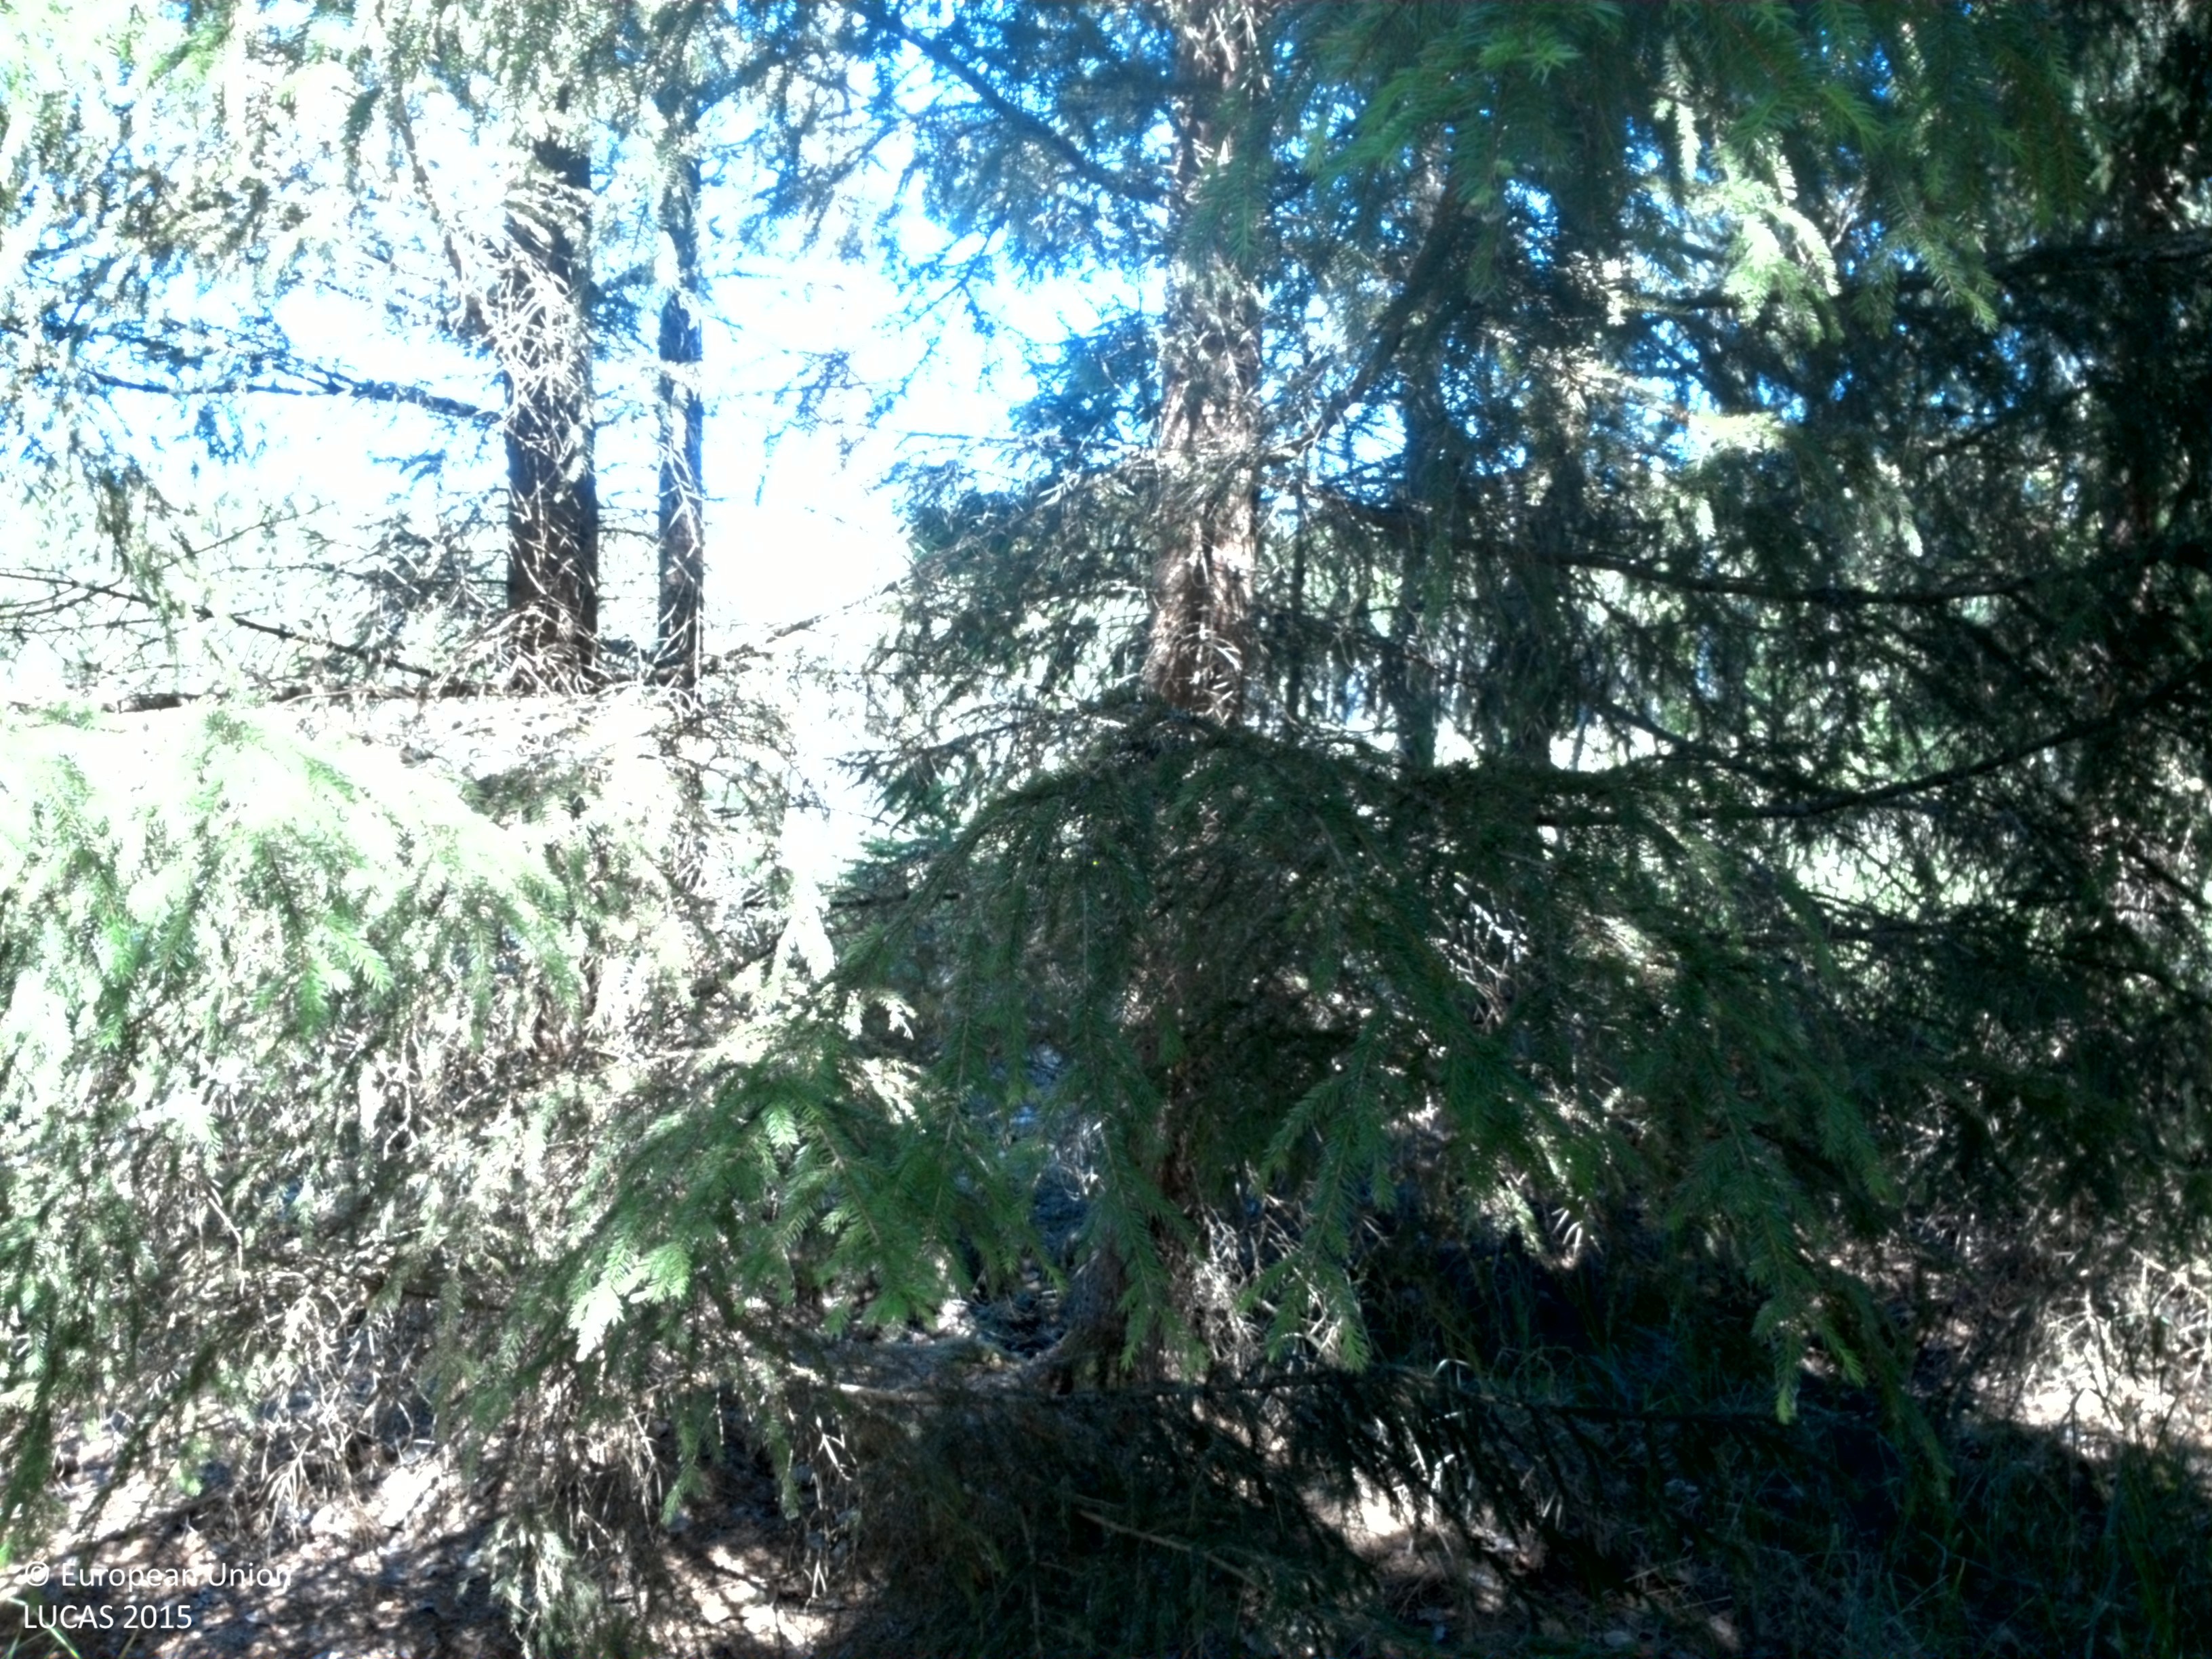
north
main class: Woodland
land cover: Spruce dominated coniferous woodland
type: boreal forest
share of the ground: > 75 %
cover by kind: coniferous forest trees 75 %, herbaceous plants 20 %, broadleaved forest trees 5 %
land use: Forestry
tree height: > 5 m
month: July
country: SE
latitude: 60.0581
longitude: 16.6904
